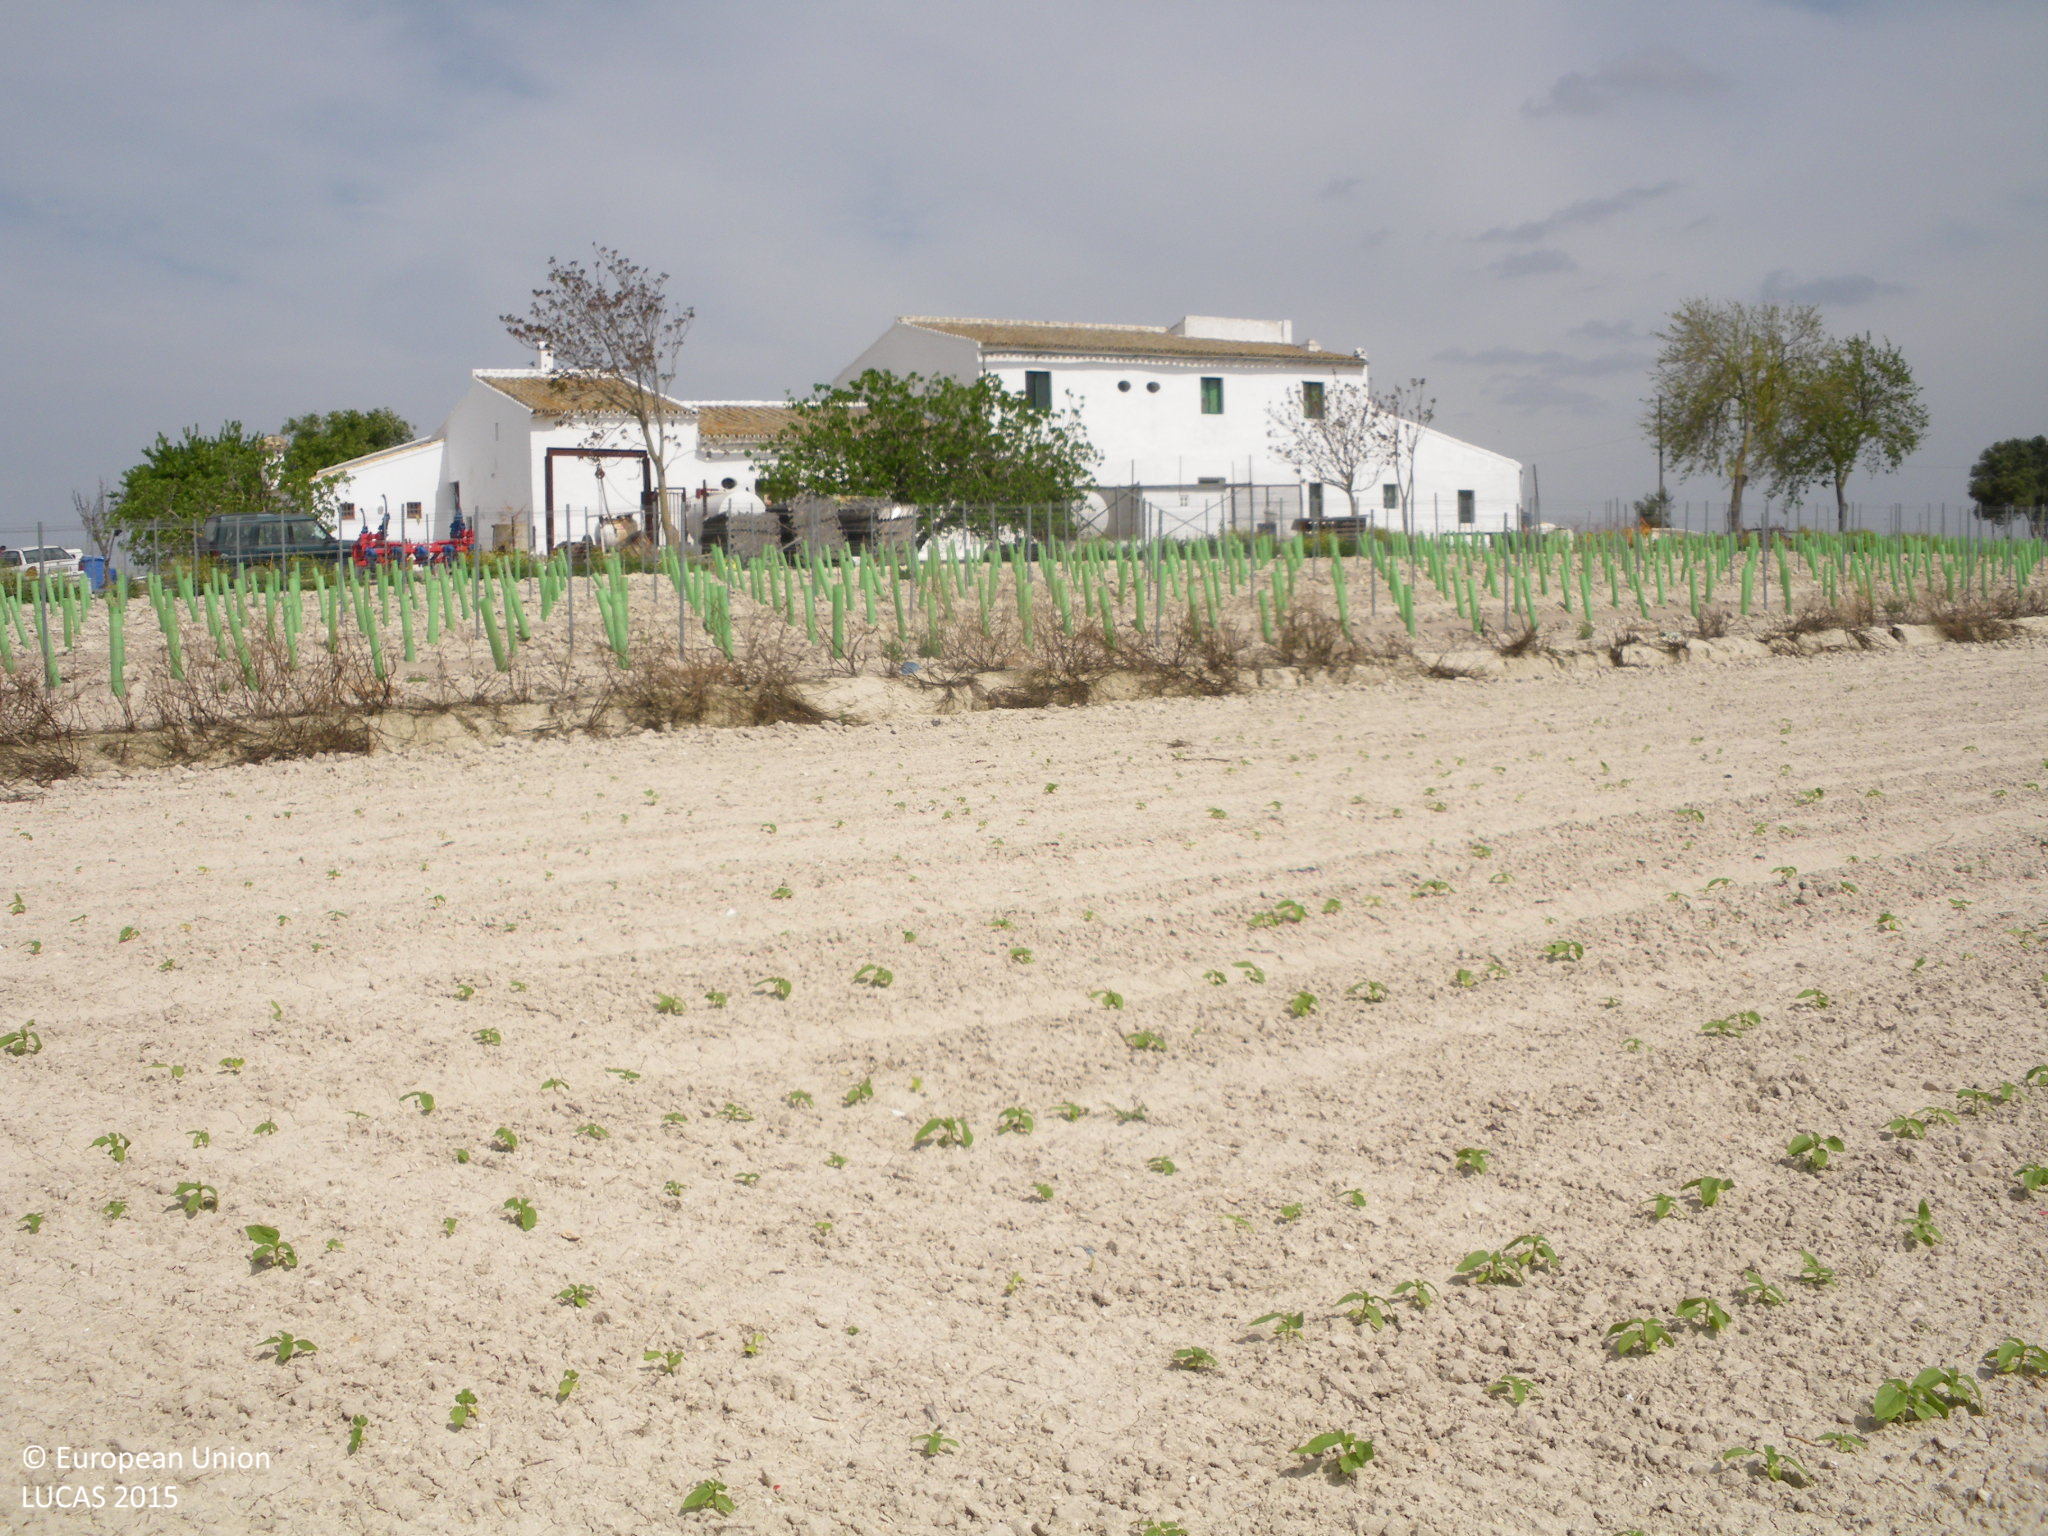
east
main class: Cropland
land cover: Sunflower
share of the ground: < 10 %
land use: Agriculture (excluding fallow land and kitchen gardens)
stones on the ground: < 10 %
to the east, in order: Sunflower; Other structural elements; Vineyards; Lines of trees; Artificial constructions in urban areas; Lines of trees; Vineyards; Tracks; Vineyards
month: April
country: ES
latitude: 36.6758
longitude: -6.2274
